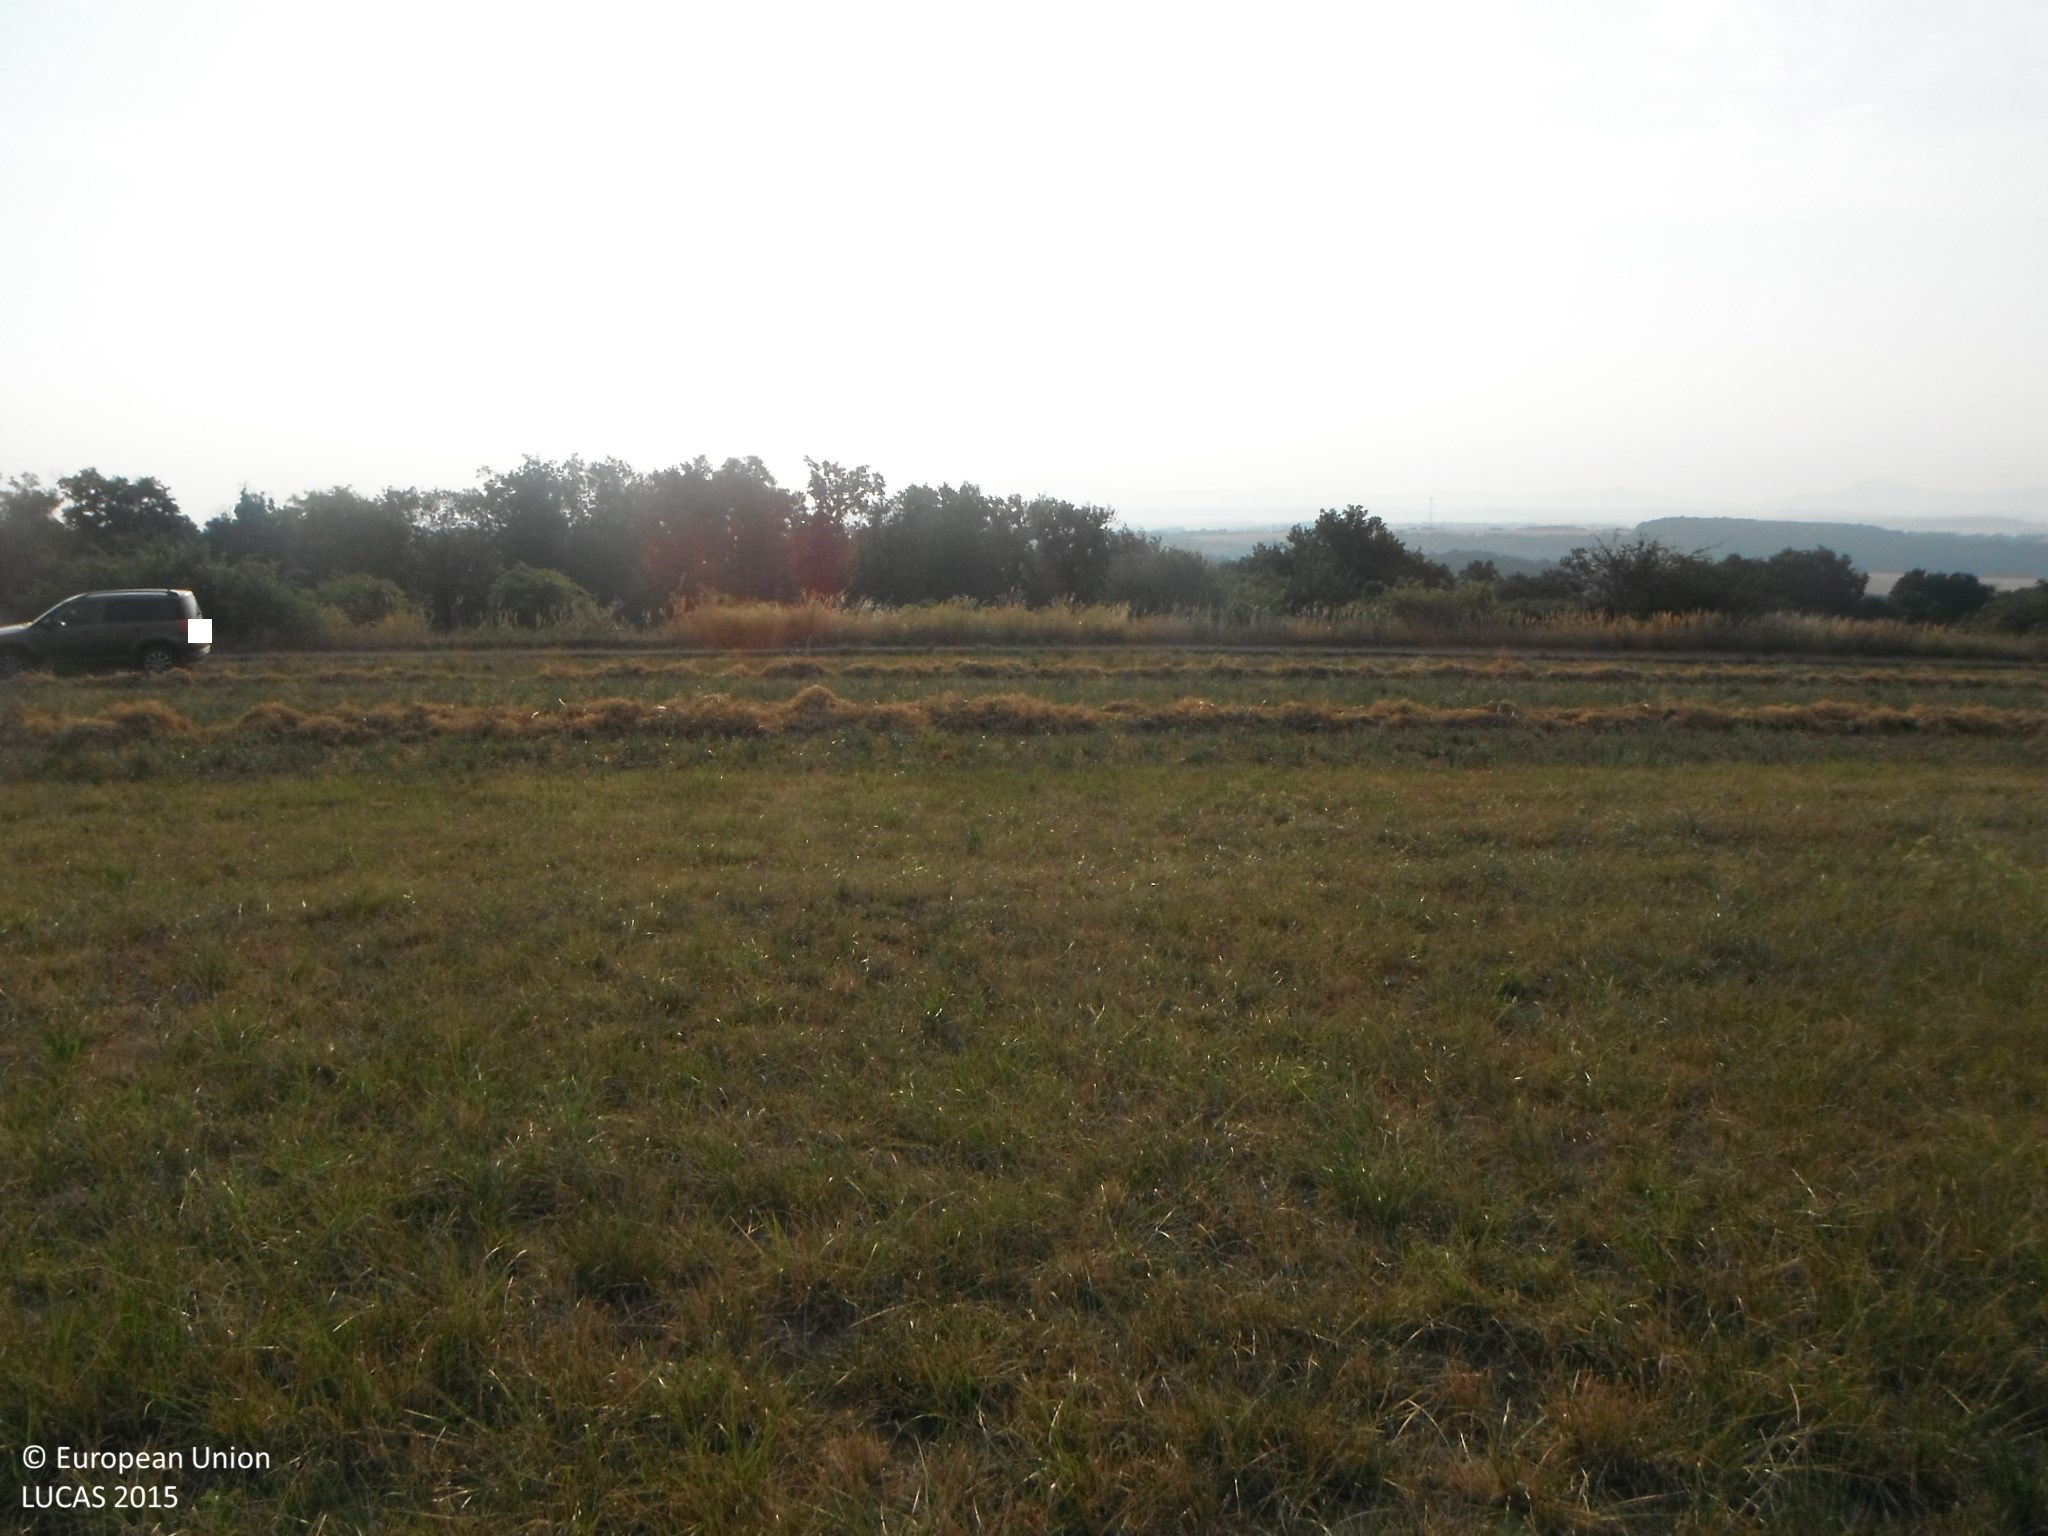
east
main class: Cropland
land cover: Dry pulses
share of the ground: < 10 %
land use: Agriculture (excluding fallow land and kitchen gardens)
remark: Harvested field
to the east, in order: Dry pulses; Tracks; Spontaneously vegetated surfaces; Shrubland without tree cover; Grassland without tree/shrub cover; Broadleaved woodland; Common wheat
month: August
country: SK
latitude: 48.4681
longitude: 17.8436
